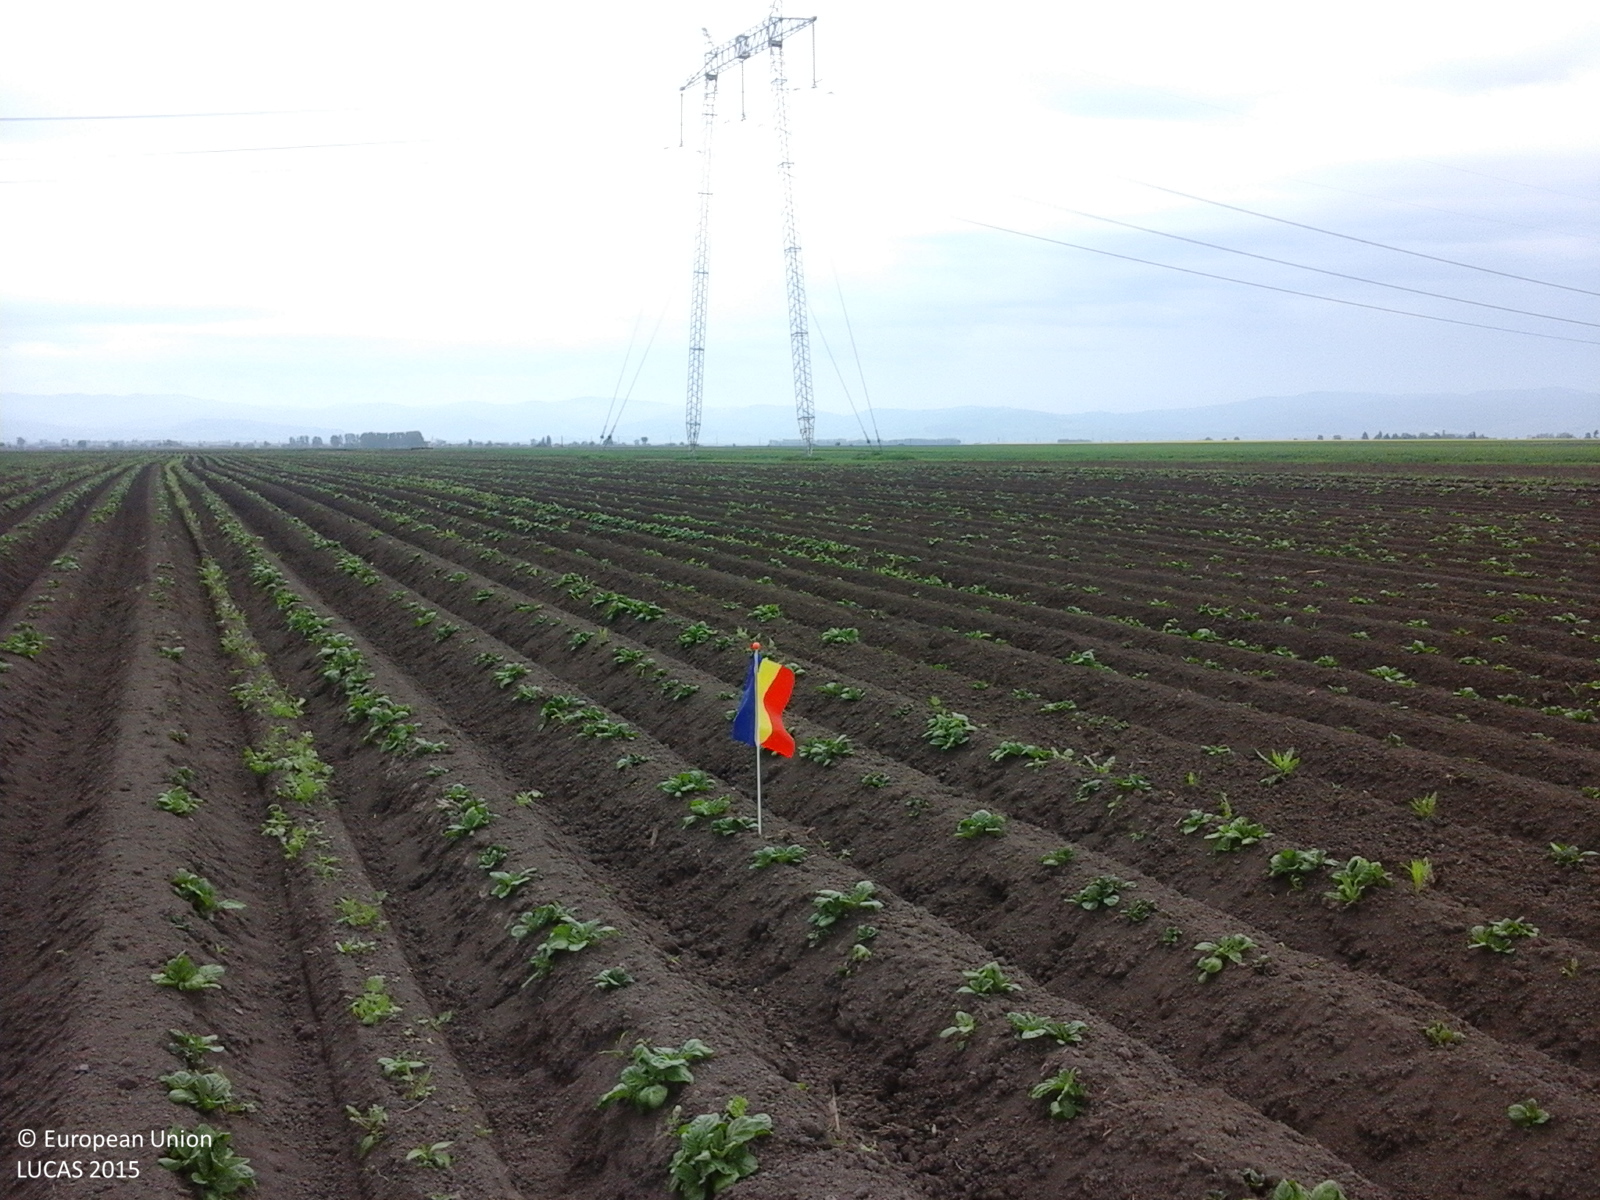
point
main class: Cropland
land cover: Potatoes
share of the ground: < 10 %
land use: Agriculture (excluding fallow land and kitchen gardens)
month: May
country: RO
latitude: 45.8845
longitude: 26.0306
